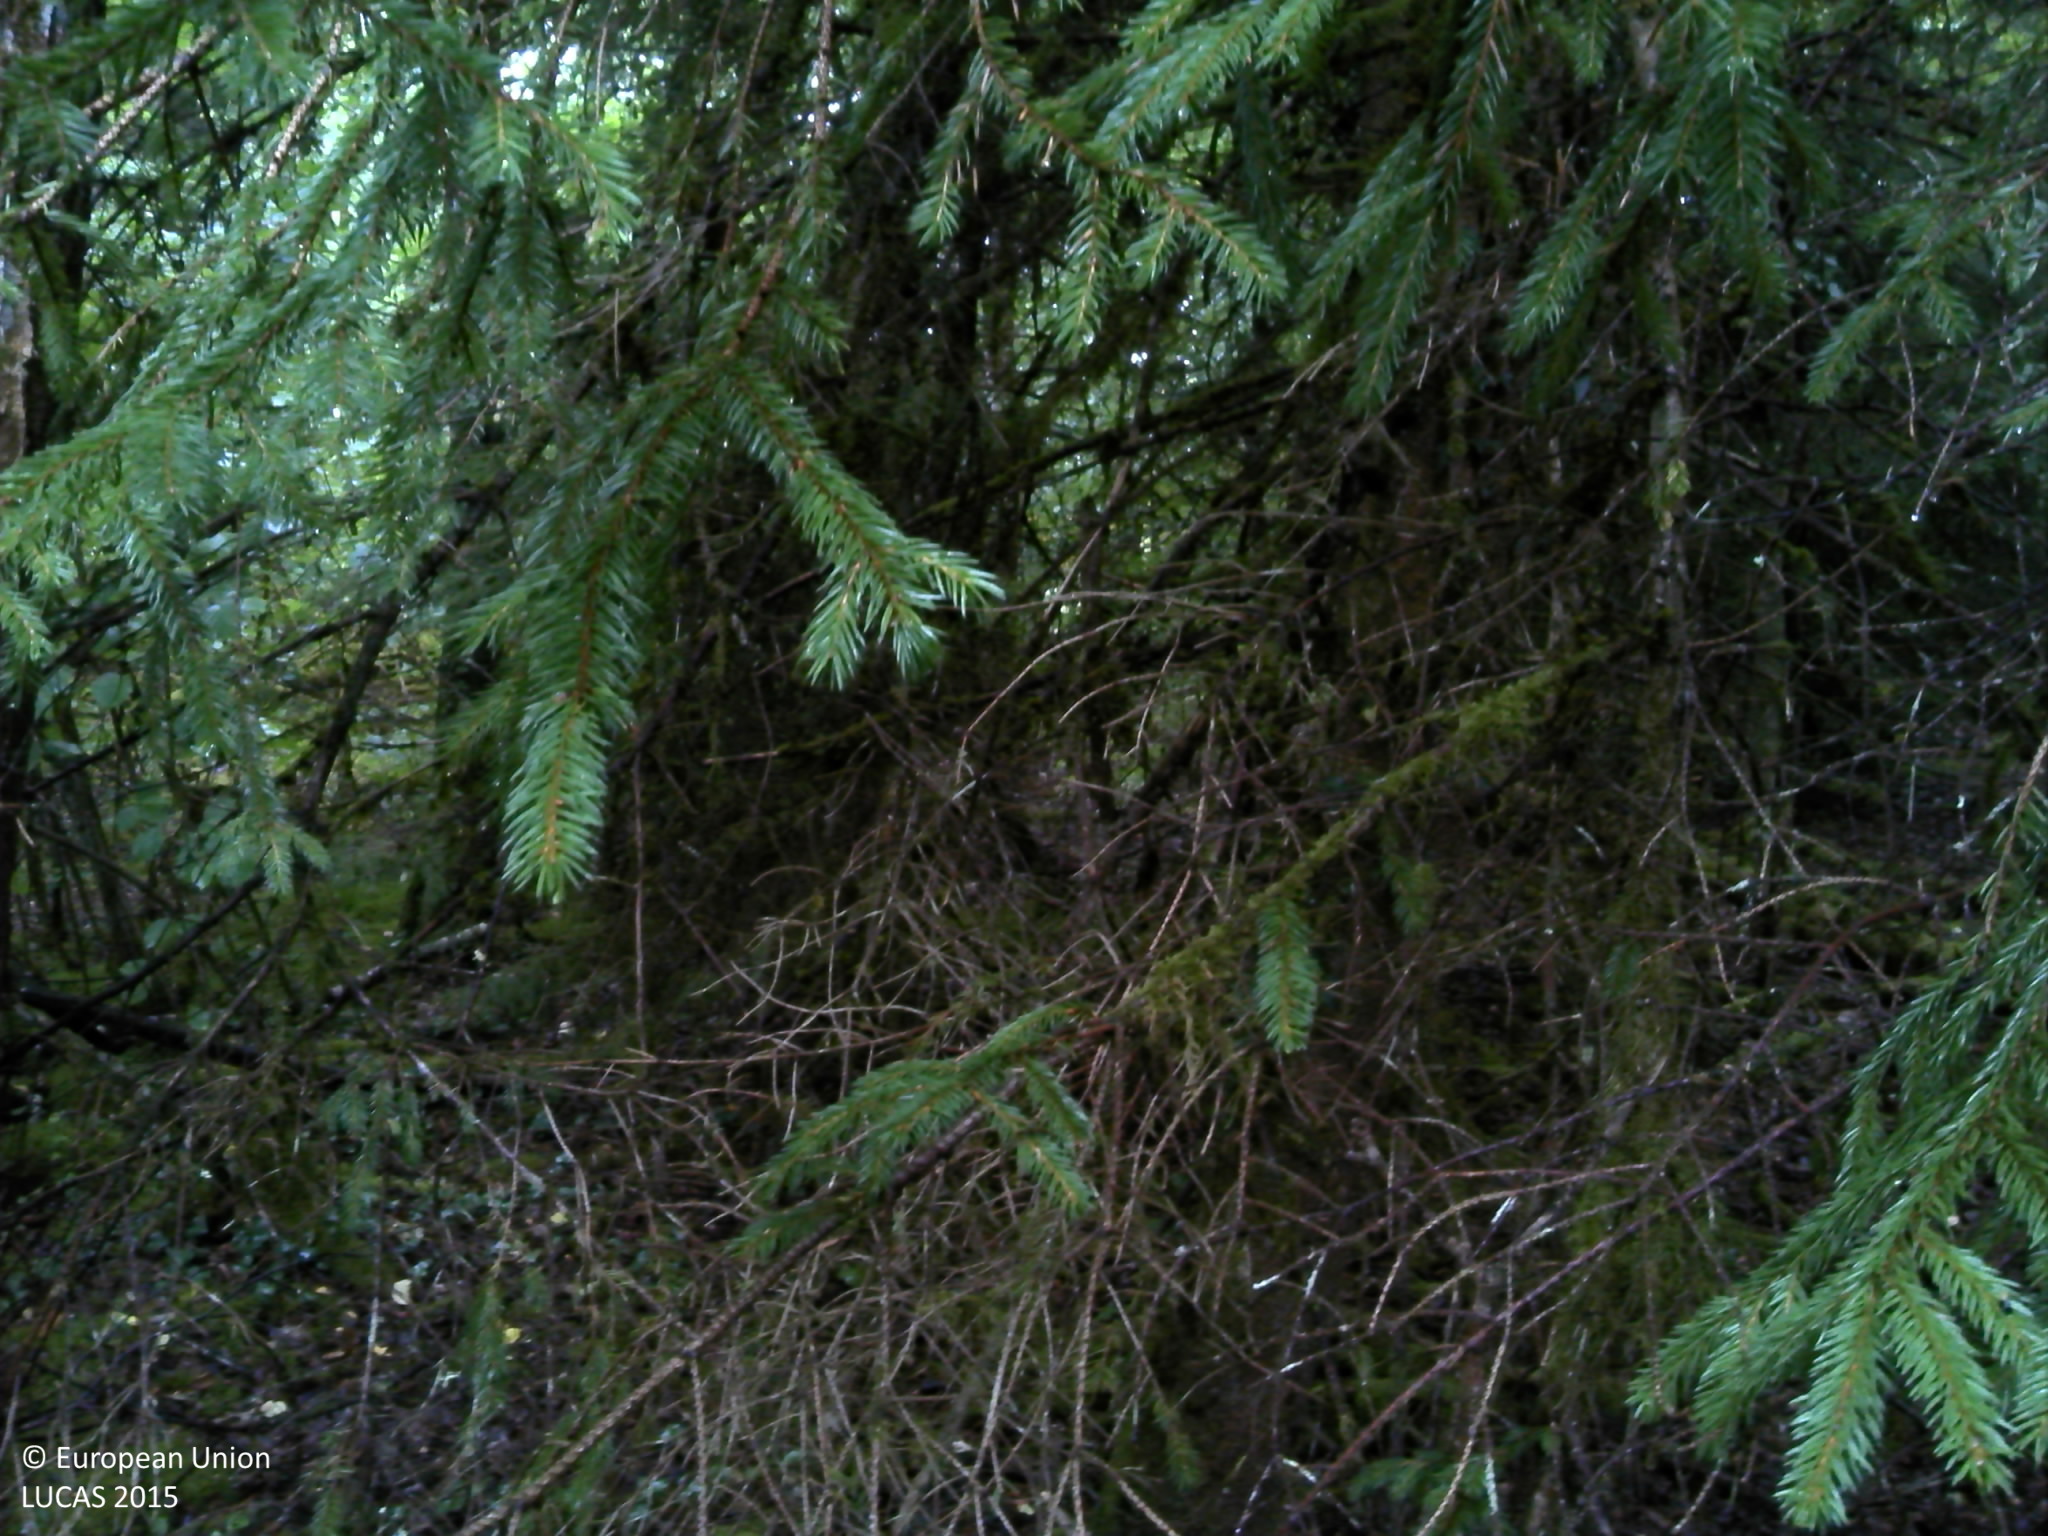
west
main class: Woodland
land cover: Spruce dominated mixed woodland
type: mountainous beech forest
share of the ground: > 75 %
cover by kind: broadleaved forest trees 35 %, coniferous forest trees 30 %, lichens and mosses 20 %, unconsolidated bare surface 15 %
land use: Semi-natural and natural areas not in use
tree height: > 5 m
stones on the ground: < 10 %
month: August
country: FR
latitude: 45.4270
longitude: 2.3679
